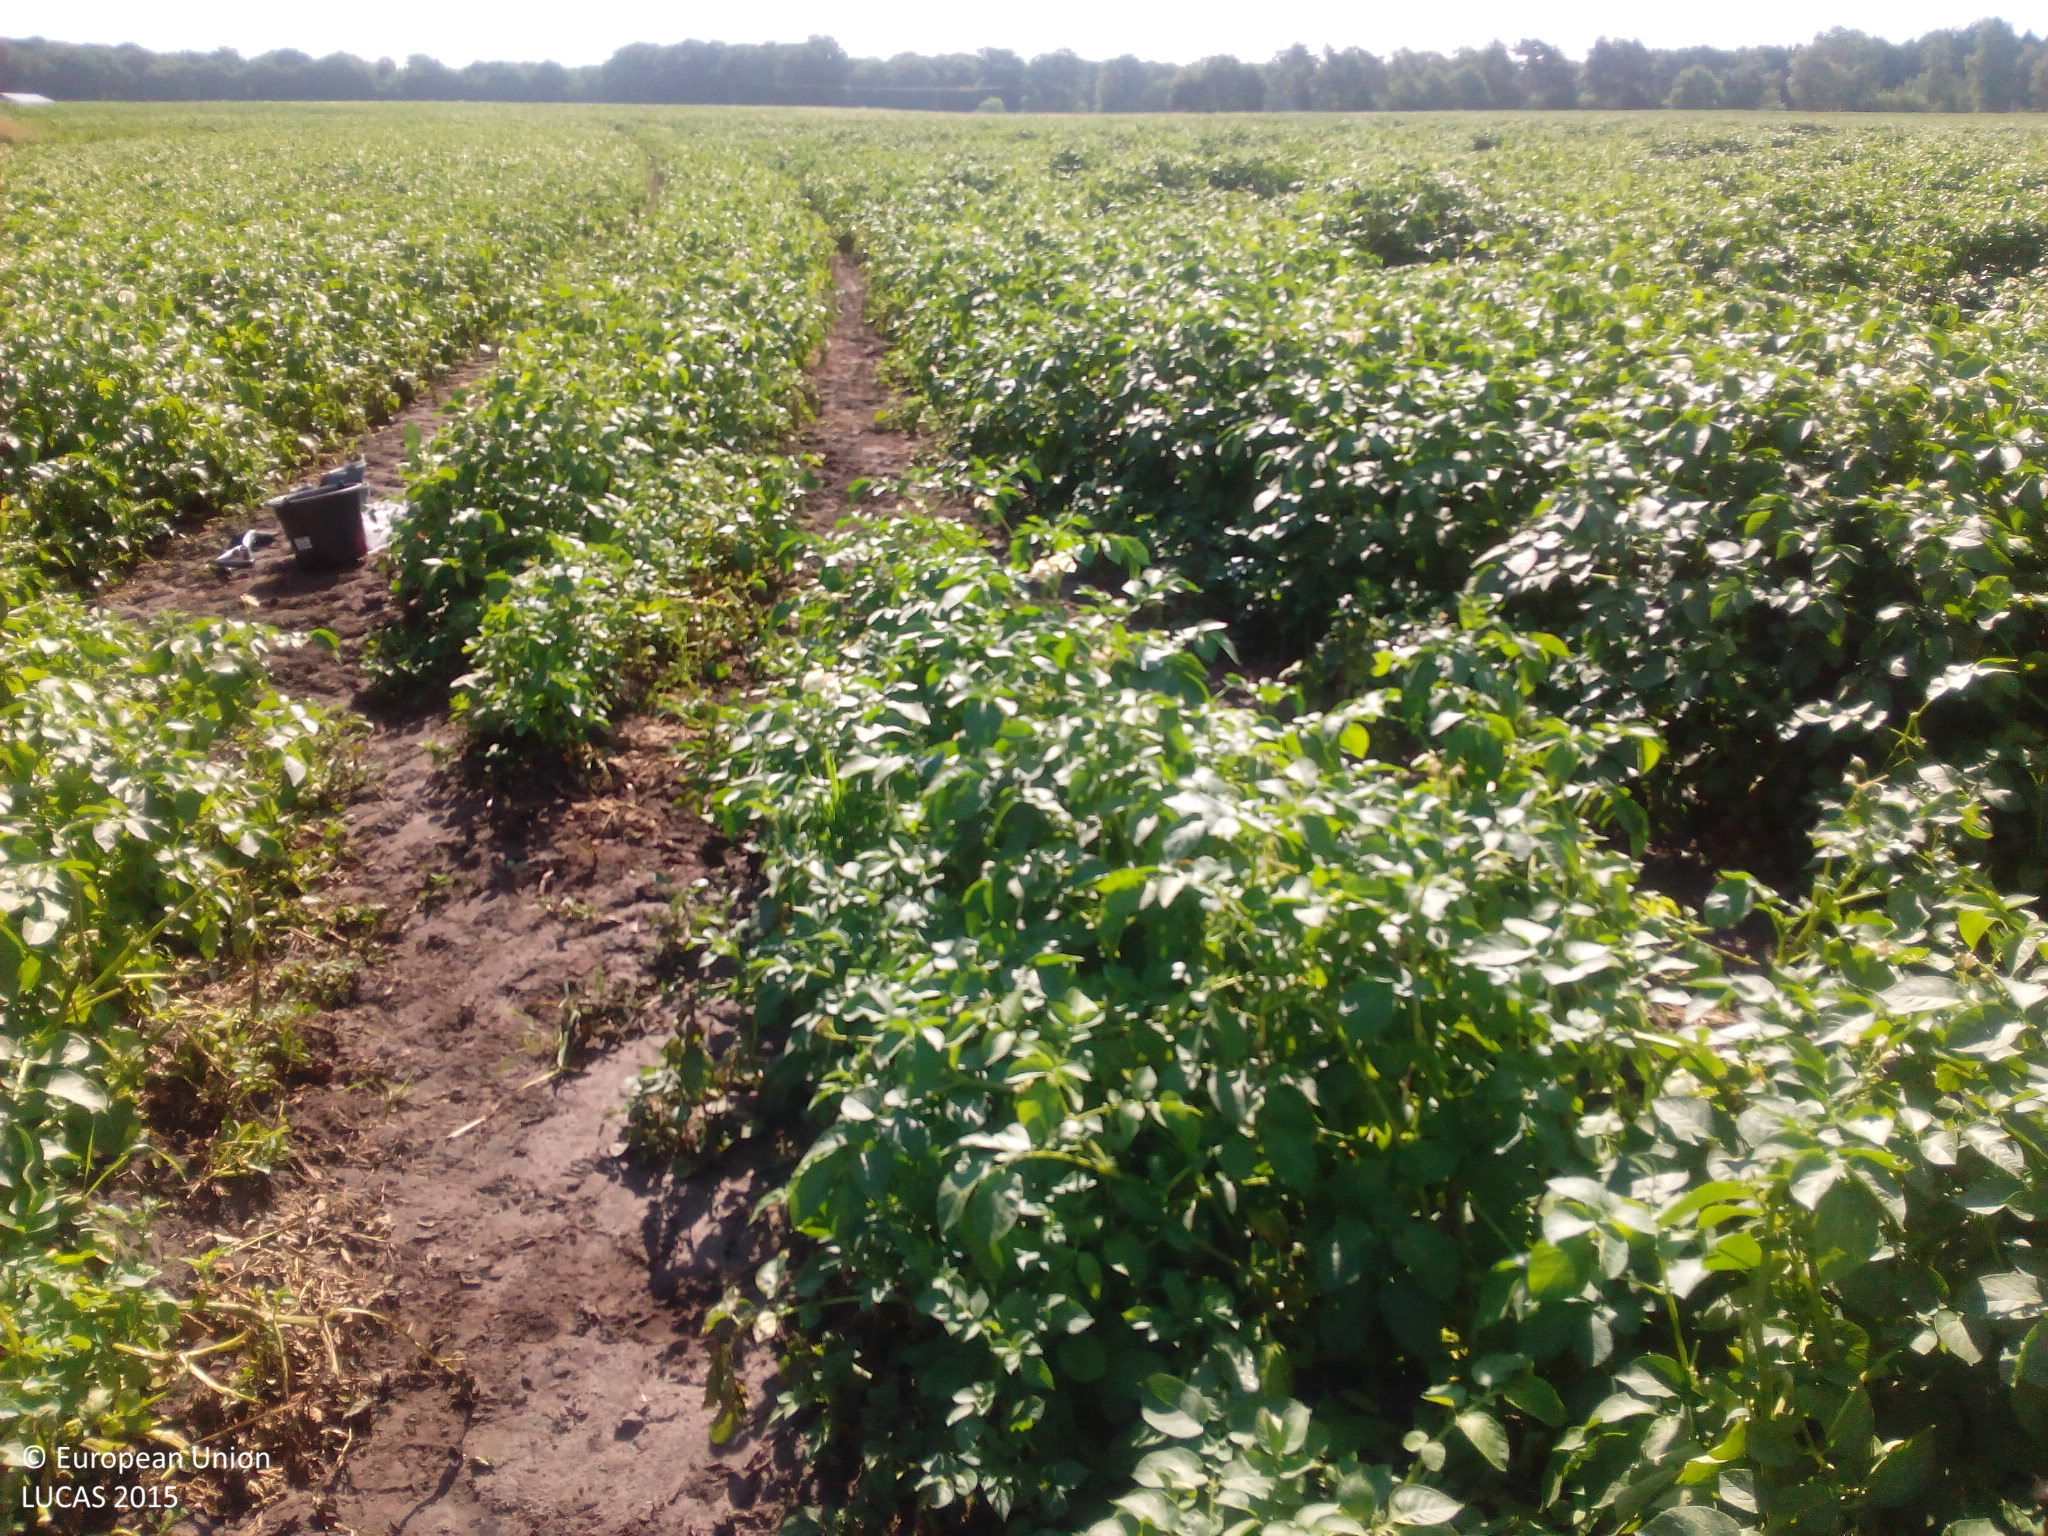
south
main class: Cropland
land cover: Potatoes
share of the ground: > 75 %
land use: Agriculture (excluding fallow land and kitchen gardens)
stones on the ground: < 10 %
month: July
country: DE
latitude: 52.7089
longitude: 7.4102
